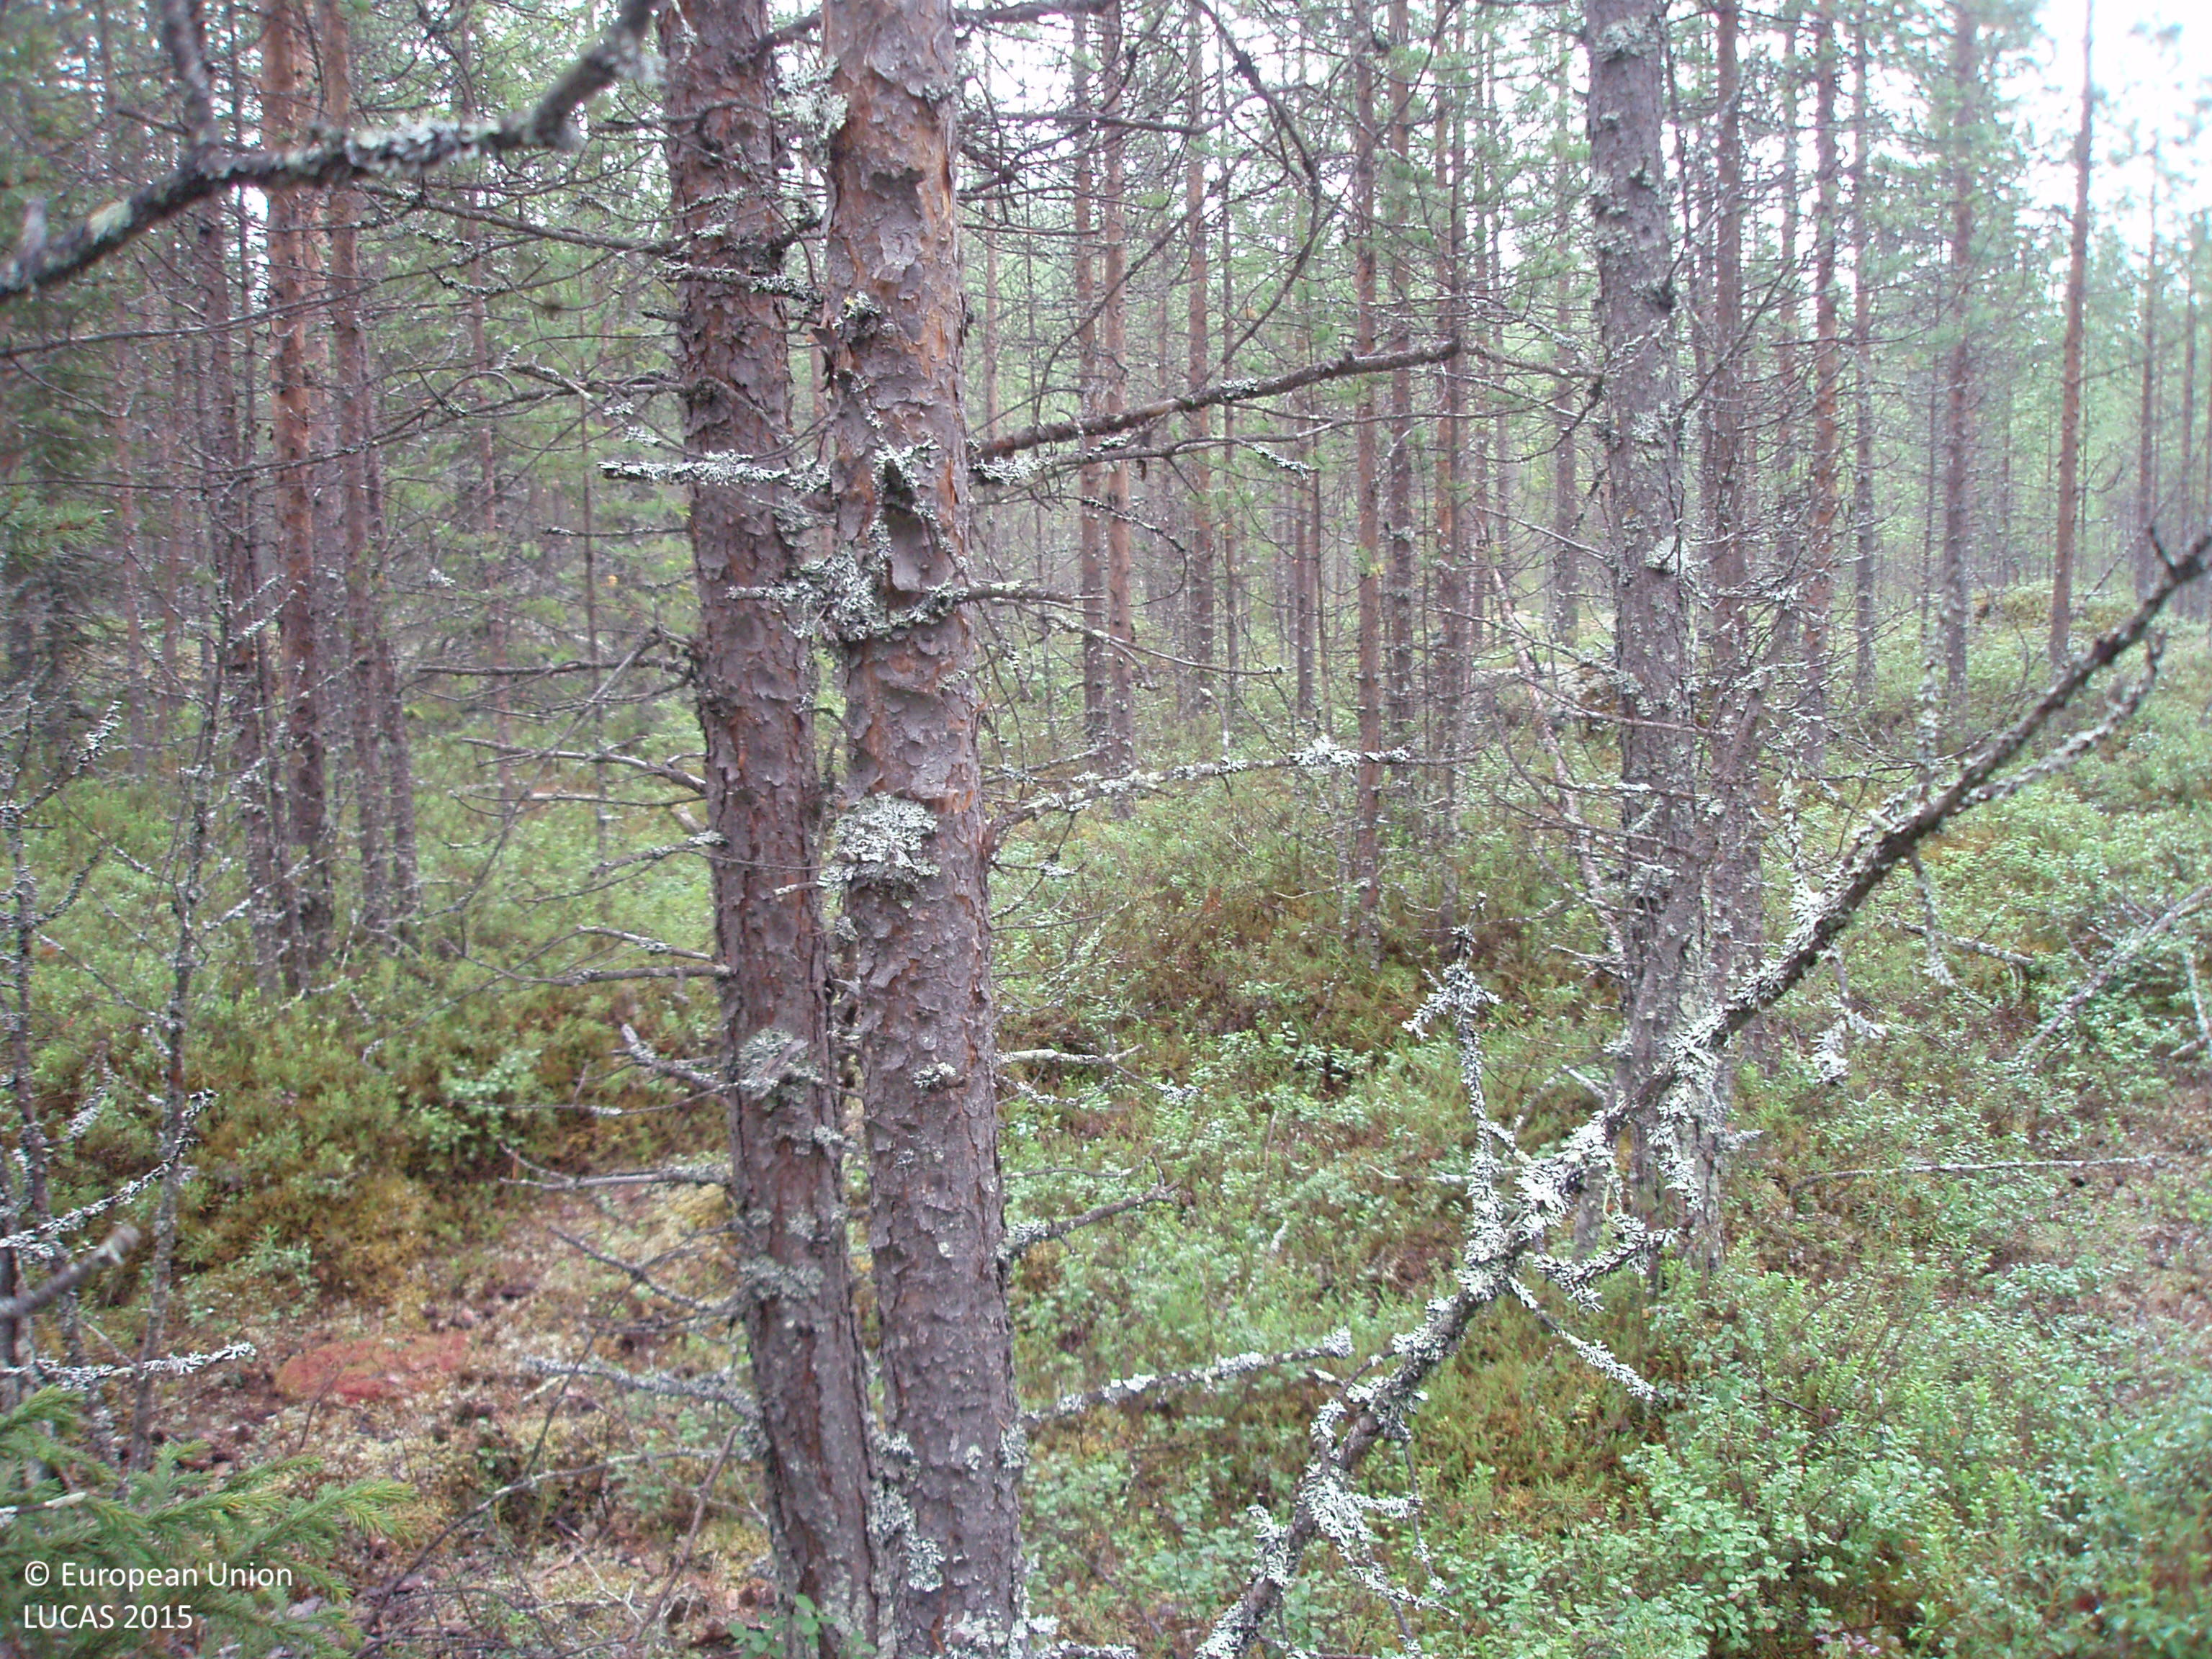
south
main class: Woodland
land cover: Pine dominated coniferous woodland
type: boreal forest
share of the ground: 50 - 75 %
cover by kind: coniferous forest trees 65 %, shrubs 35 %
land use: Forestry
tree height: > 5 m
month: July
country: FI
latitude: 66.6011
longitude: 28.0230
